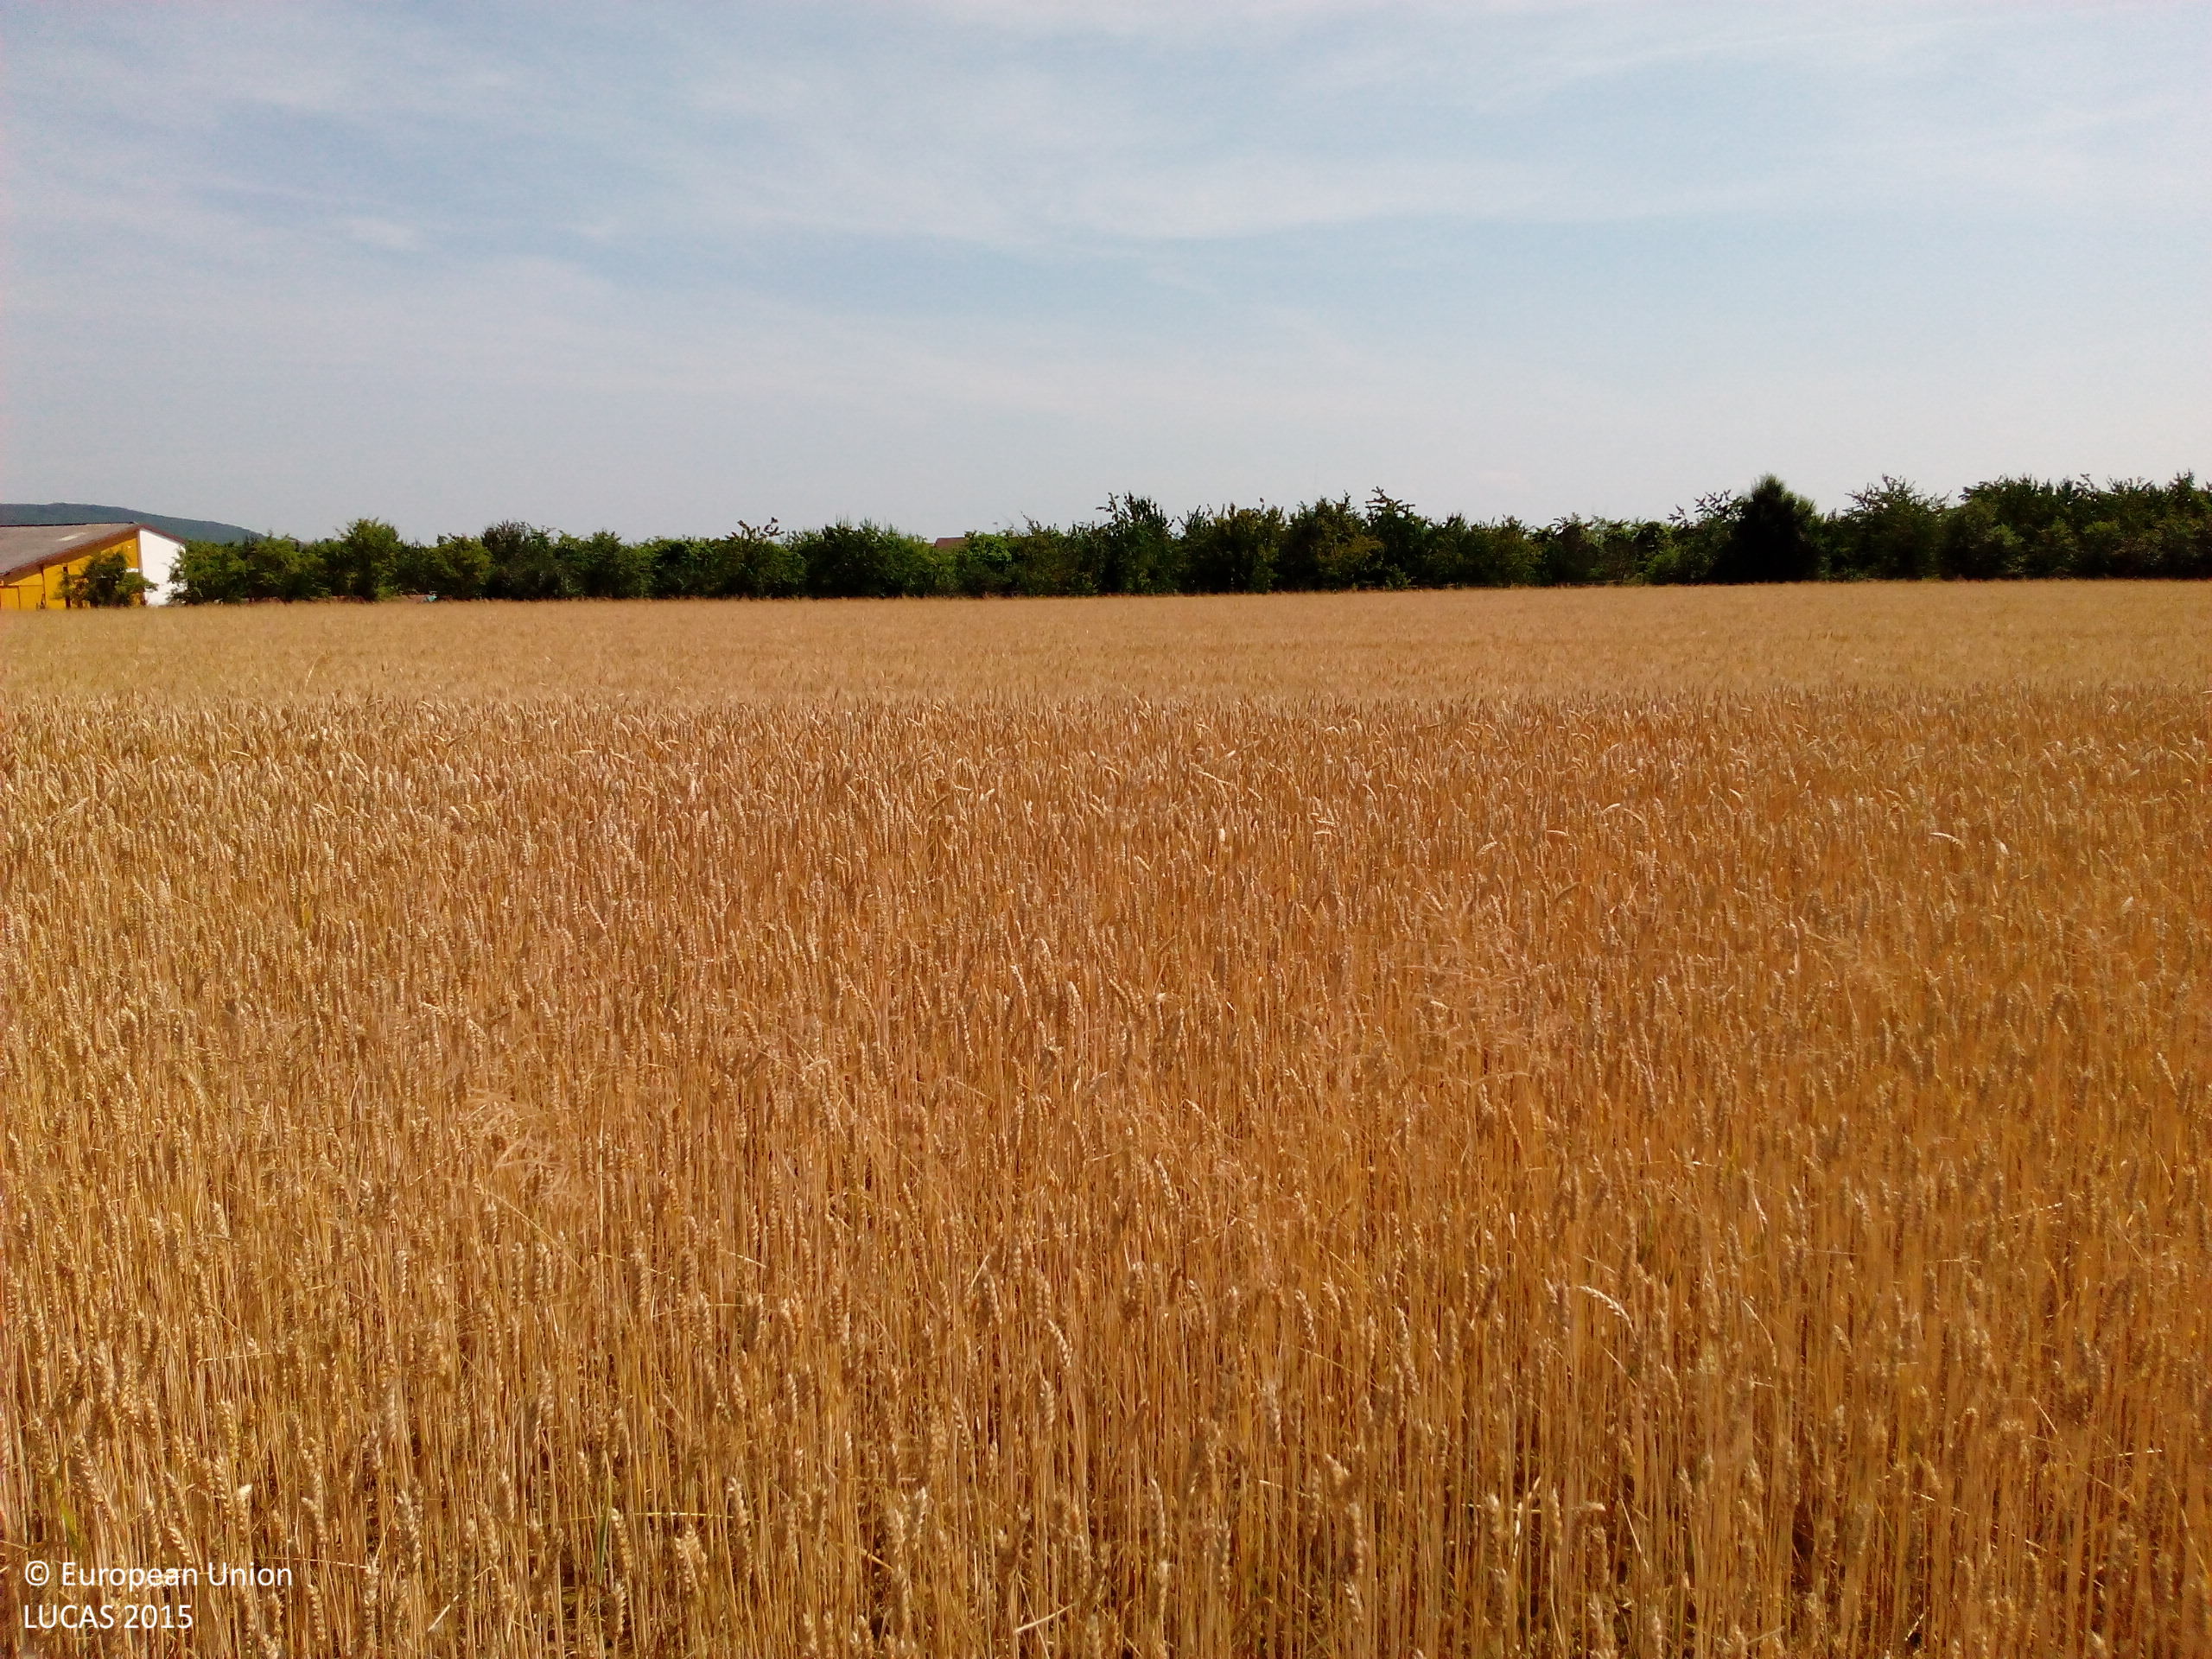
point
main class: Cropland
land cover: Common wheat
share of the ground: > 75 %
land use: Agriculture (excluding fallow land and kitchen gardens)
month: July
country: DE
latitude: 47.6391
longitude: 7.5924
